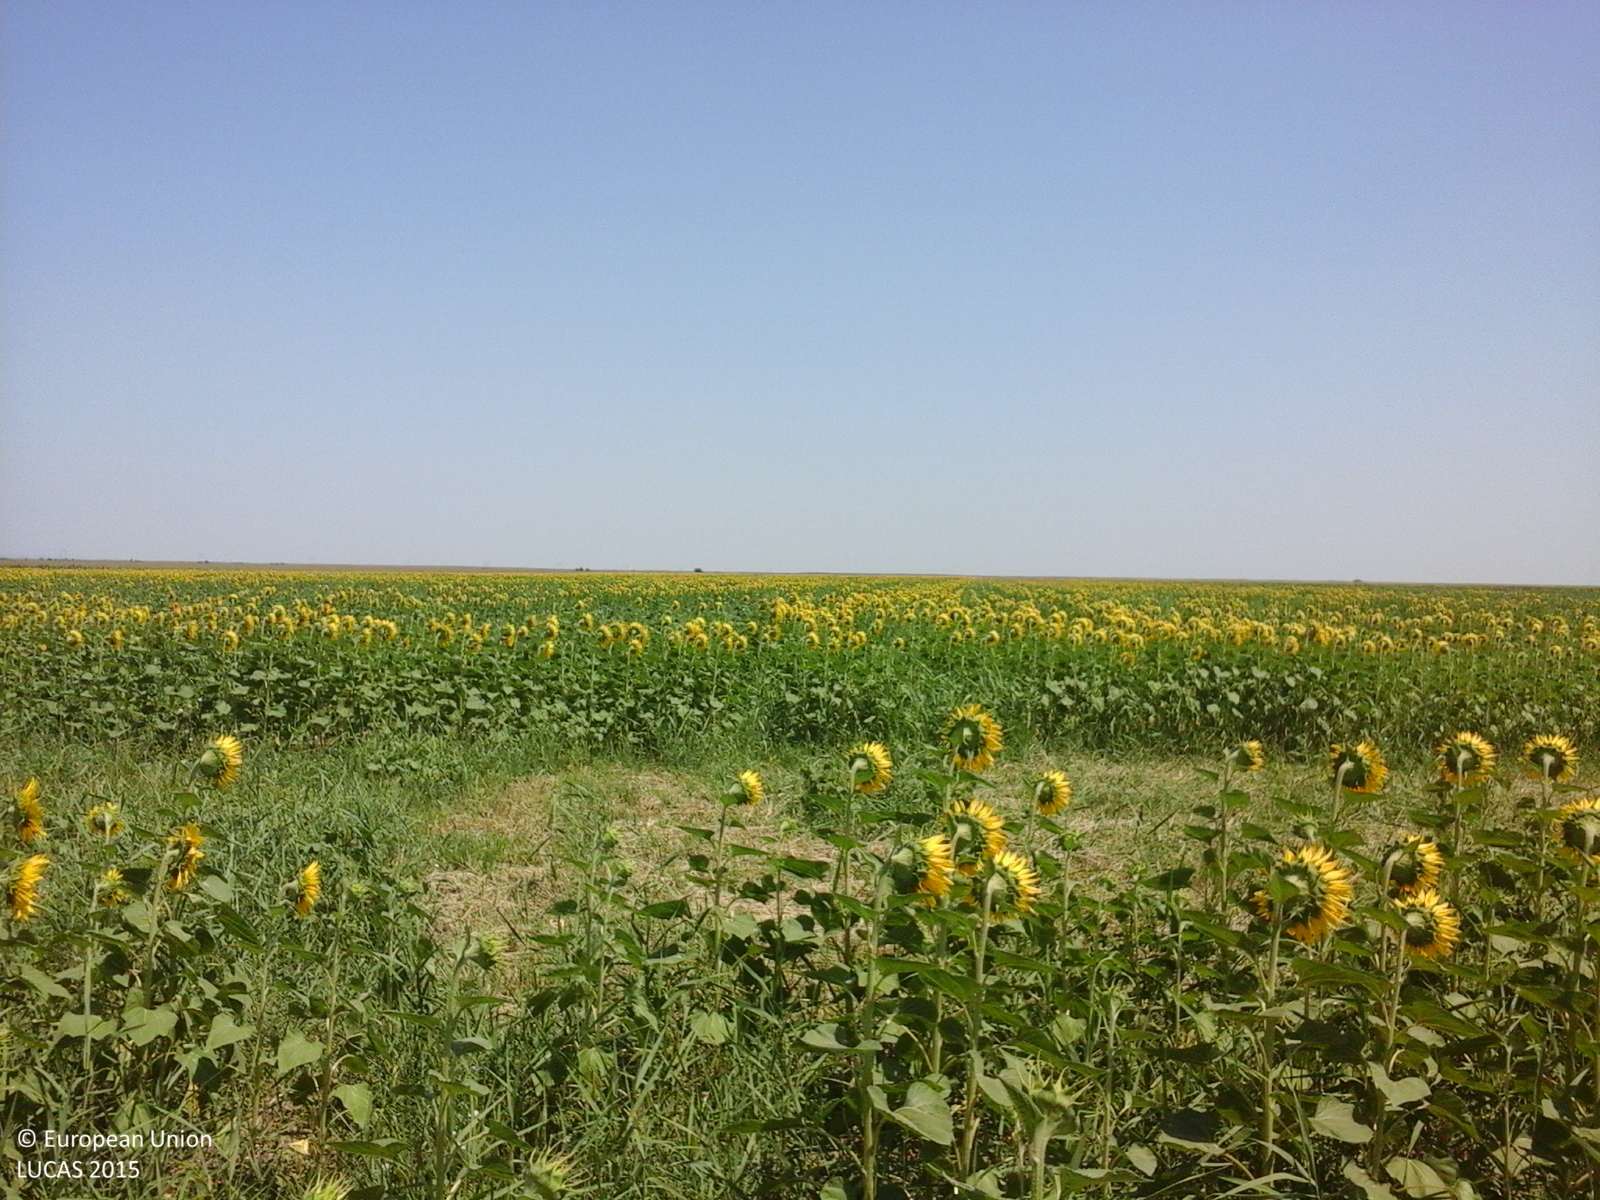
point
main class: Cropland
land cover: Sunflower
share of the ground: > 75 %
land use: Agriculture (excluding fallow land and kitchen gardens)
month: July
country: RO
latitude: 45.0361
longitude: 26.6394
